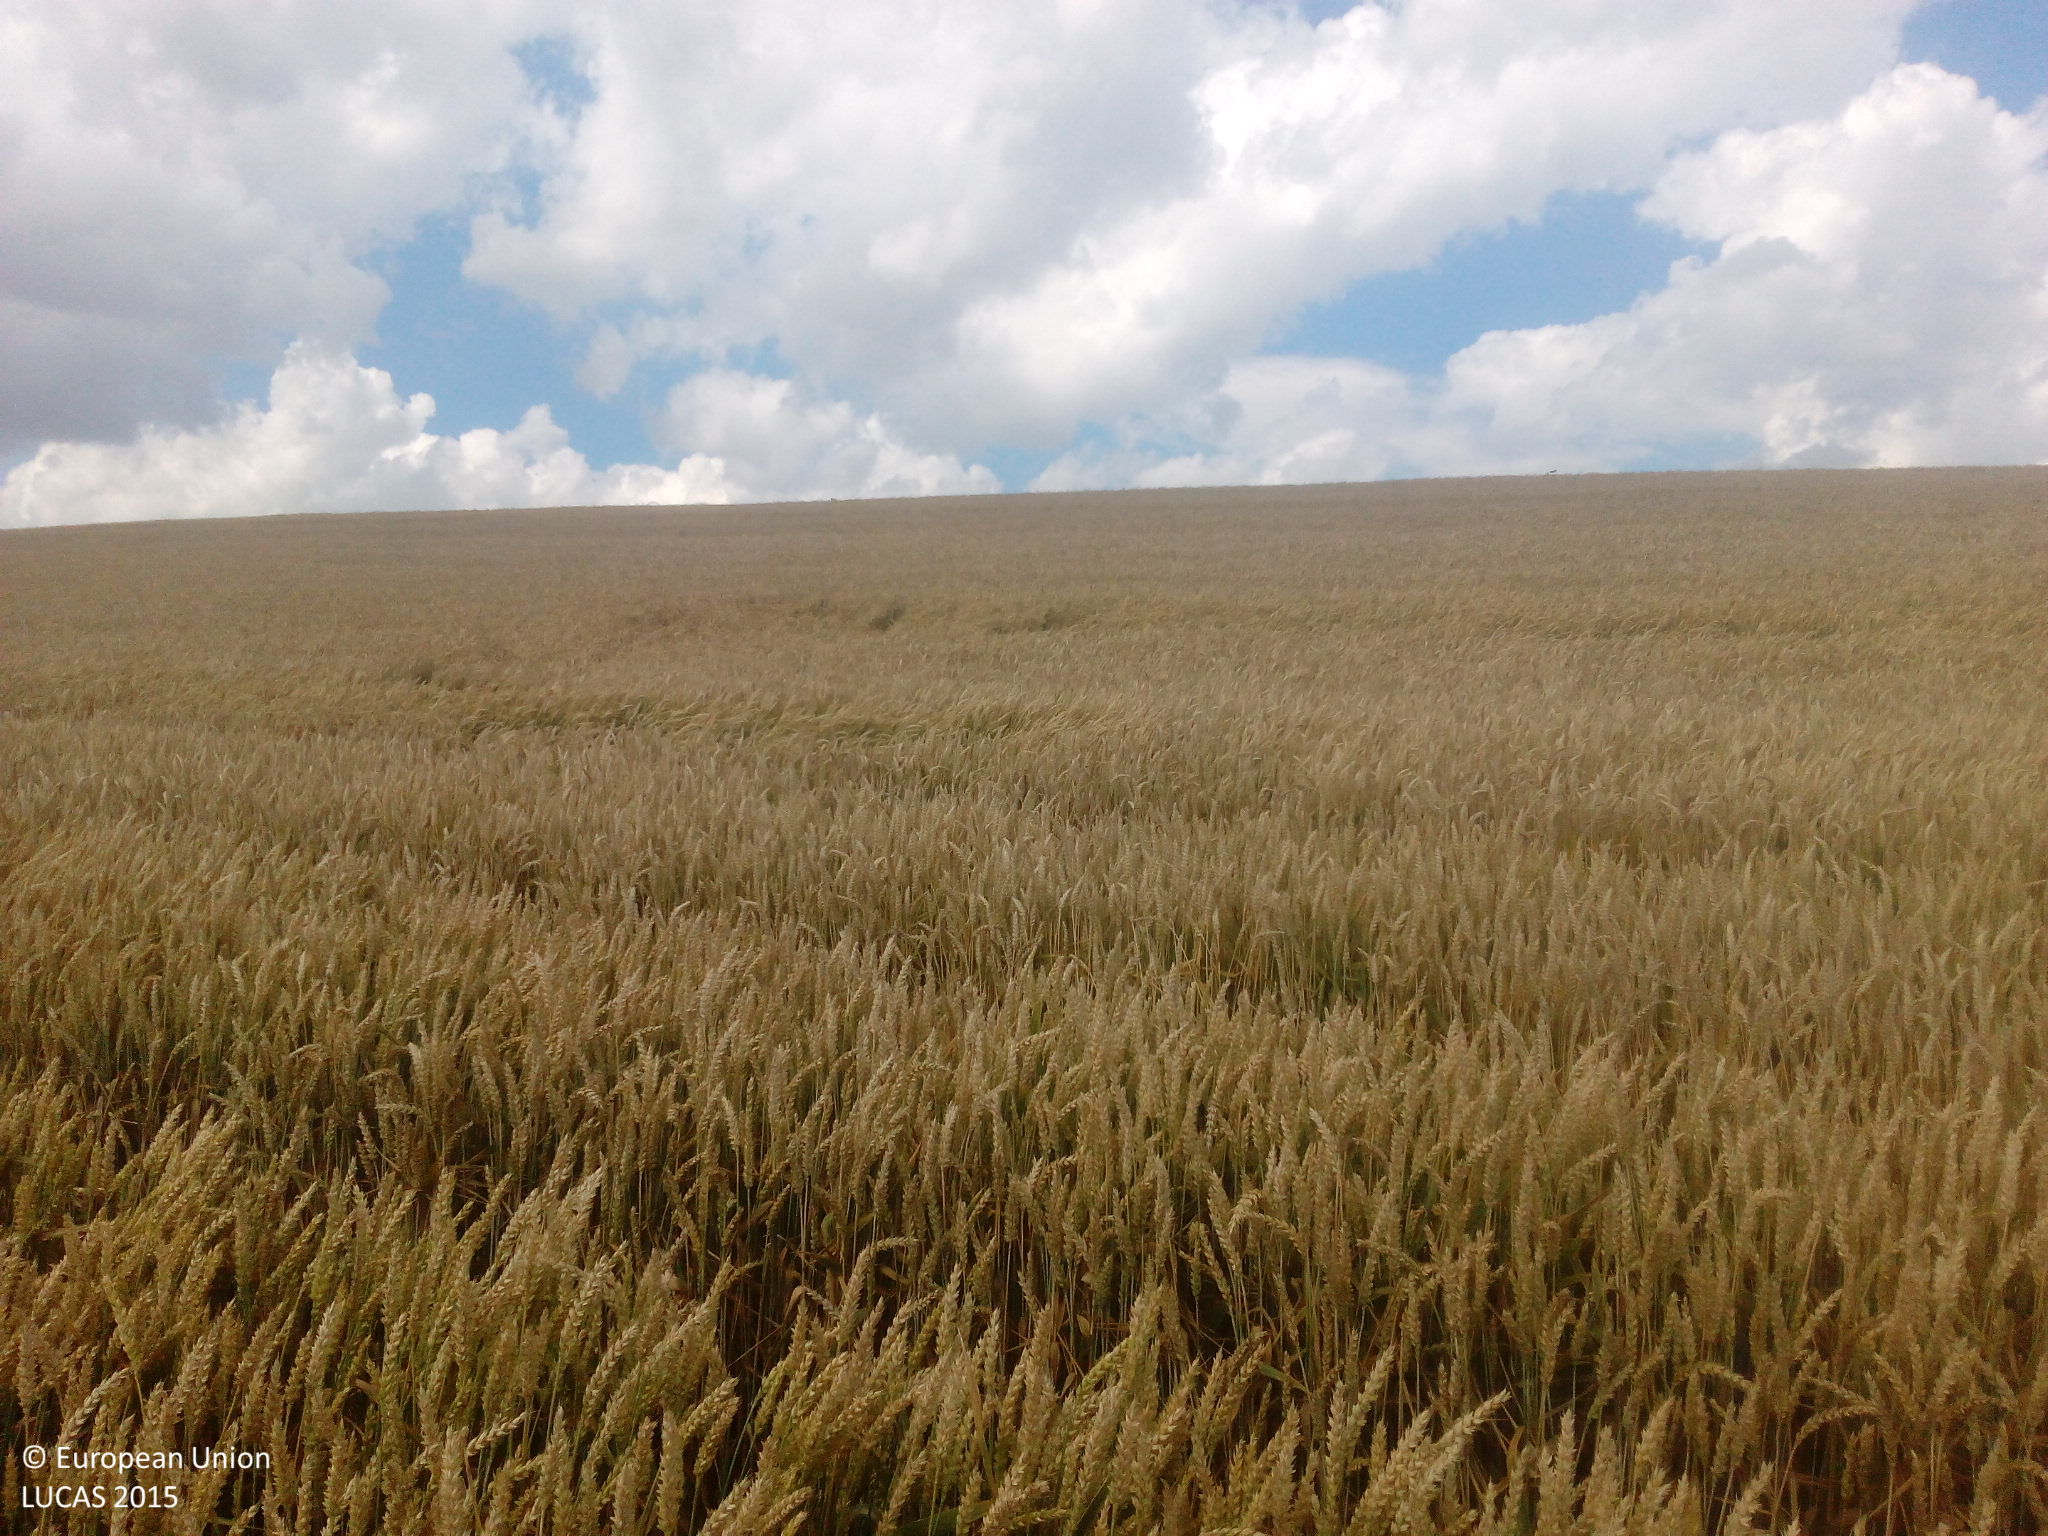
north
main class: Cropland
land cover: Common wheat
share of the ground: > 75 %
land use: Agriculture (excluding fallow land and kitchen gardens)
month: July
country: DE
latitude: 51.1588
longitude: 13.4177
